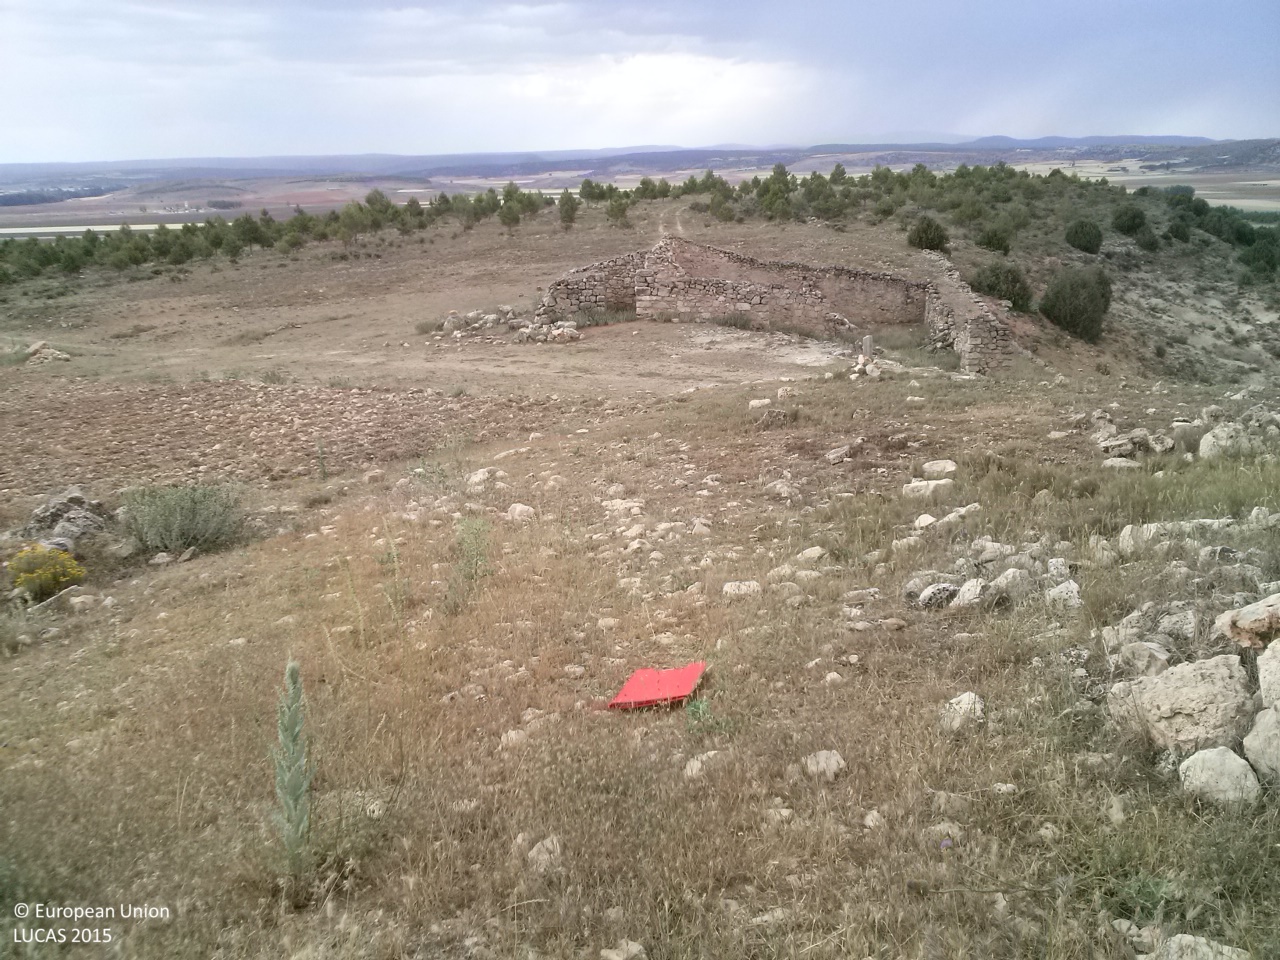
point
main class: Grassland
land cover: Grassland without tree/shrub cover
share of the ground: > 75 %
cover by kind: herbaceous plants 80 %, consolidated bare surface 20 %
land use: Agriculture (excluding fallow land and kitchen gardens)
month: June
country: ES
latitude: 39.8954
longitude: -1.8352
